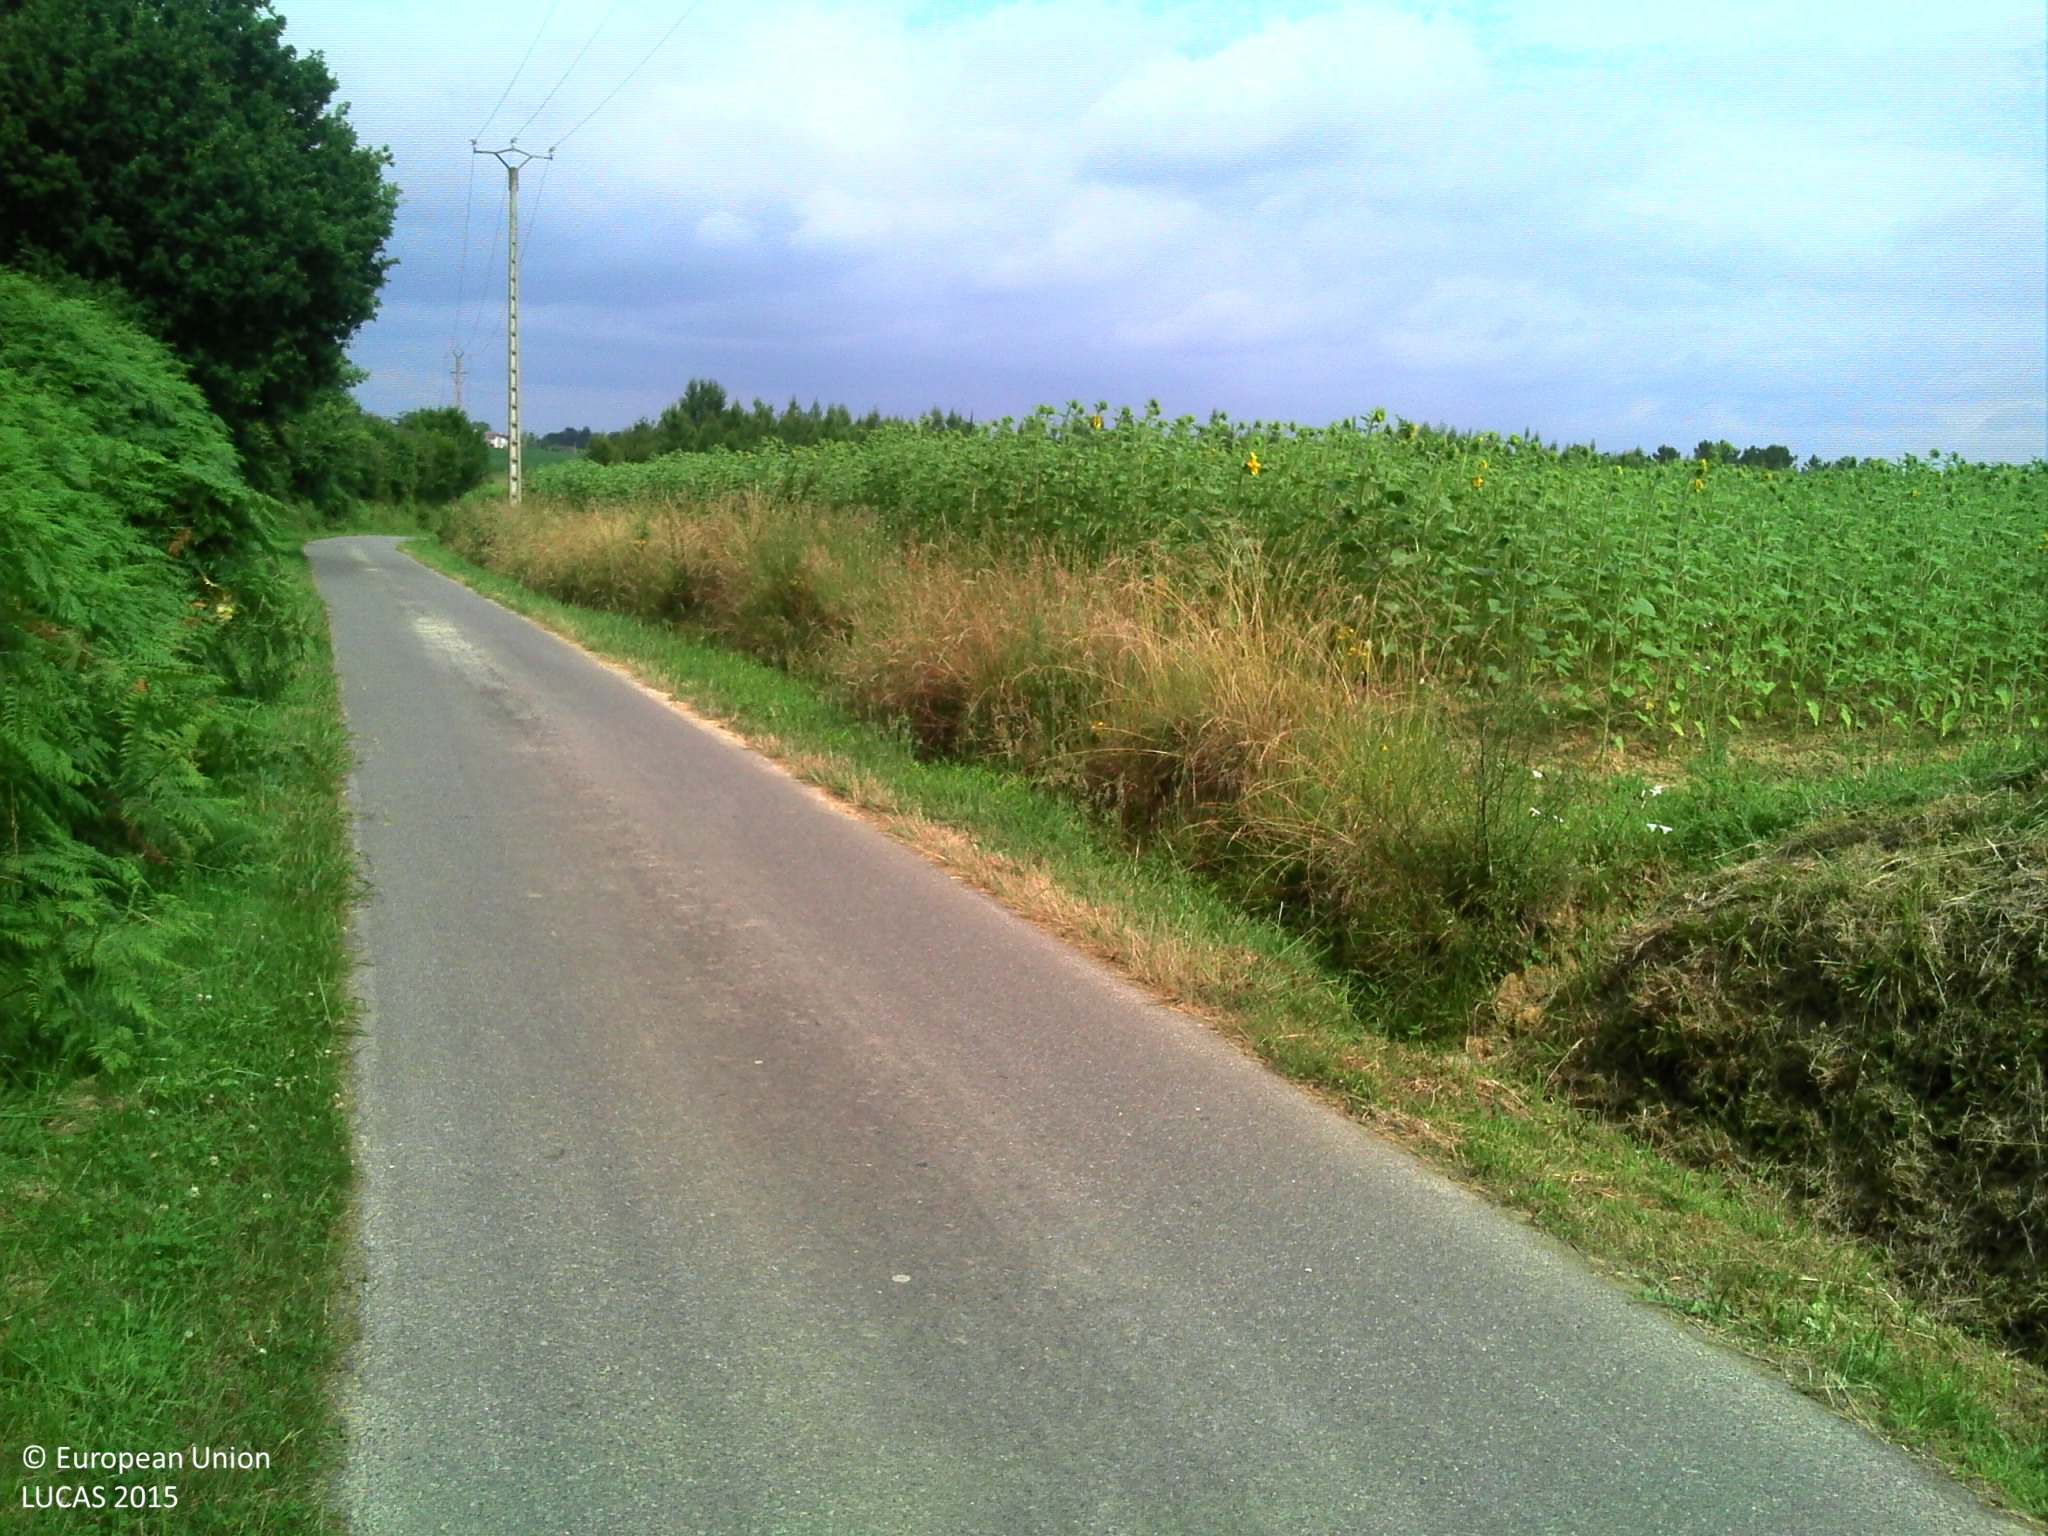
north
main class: Shrubland
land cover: Shrubland with sparse tree cover
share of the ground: > 75 %
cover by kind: shrubs 90 %, broadleaved forest trees 5 %, herbaceous plants 5 %
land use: Semi-natural and natural areas not in use
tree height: > 5 m
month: July
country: FR
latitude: 43.6082
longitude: -0.7540
